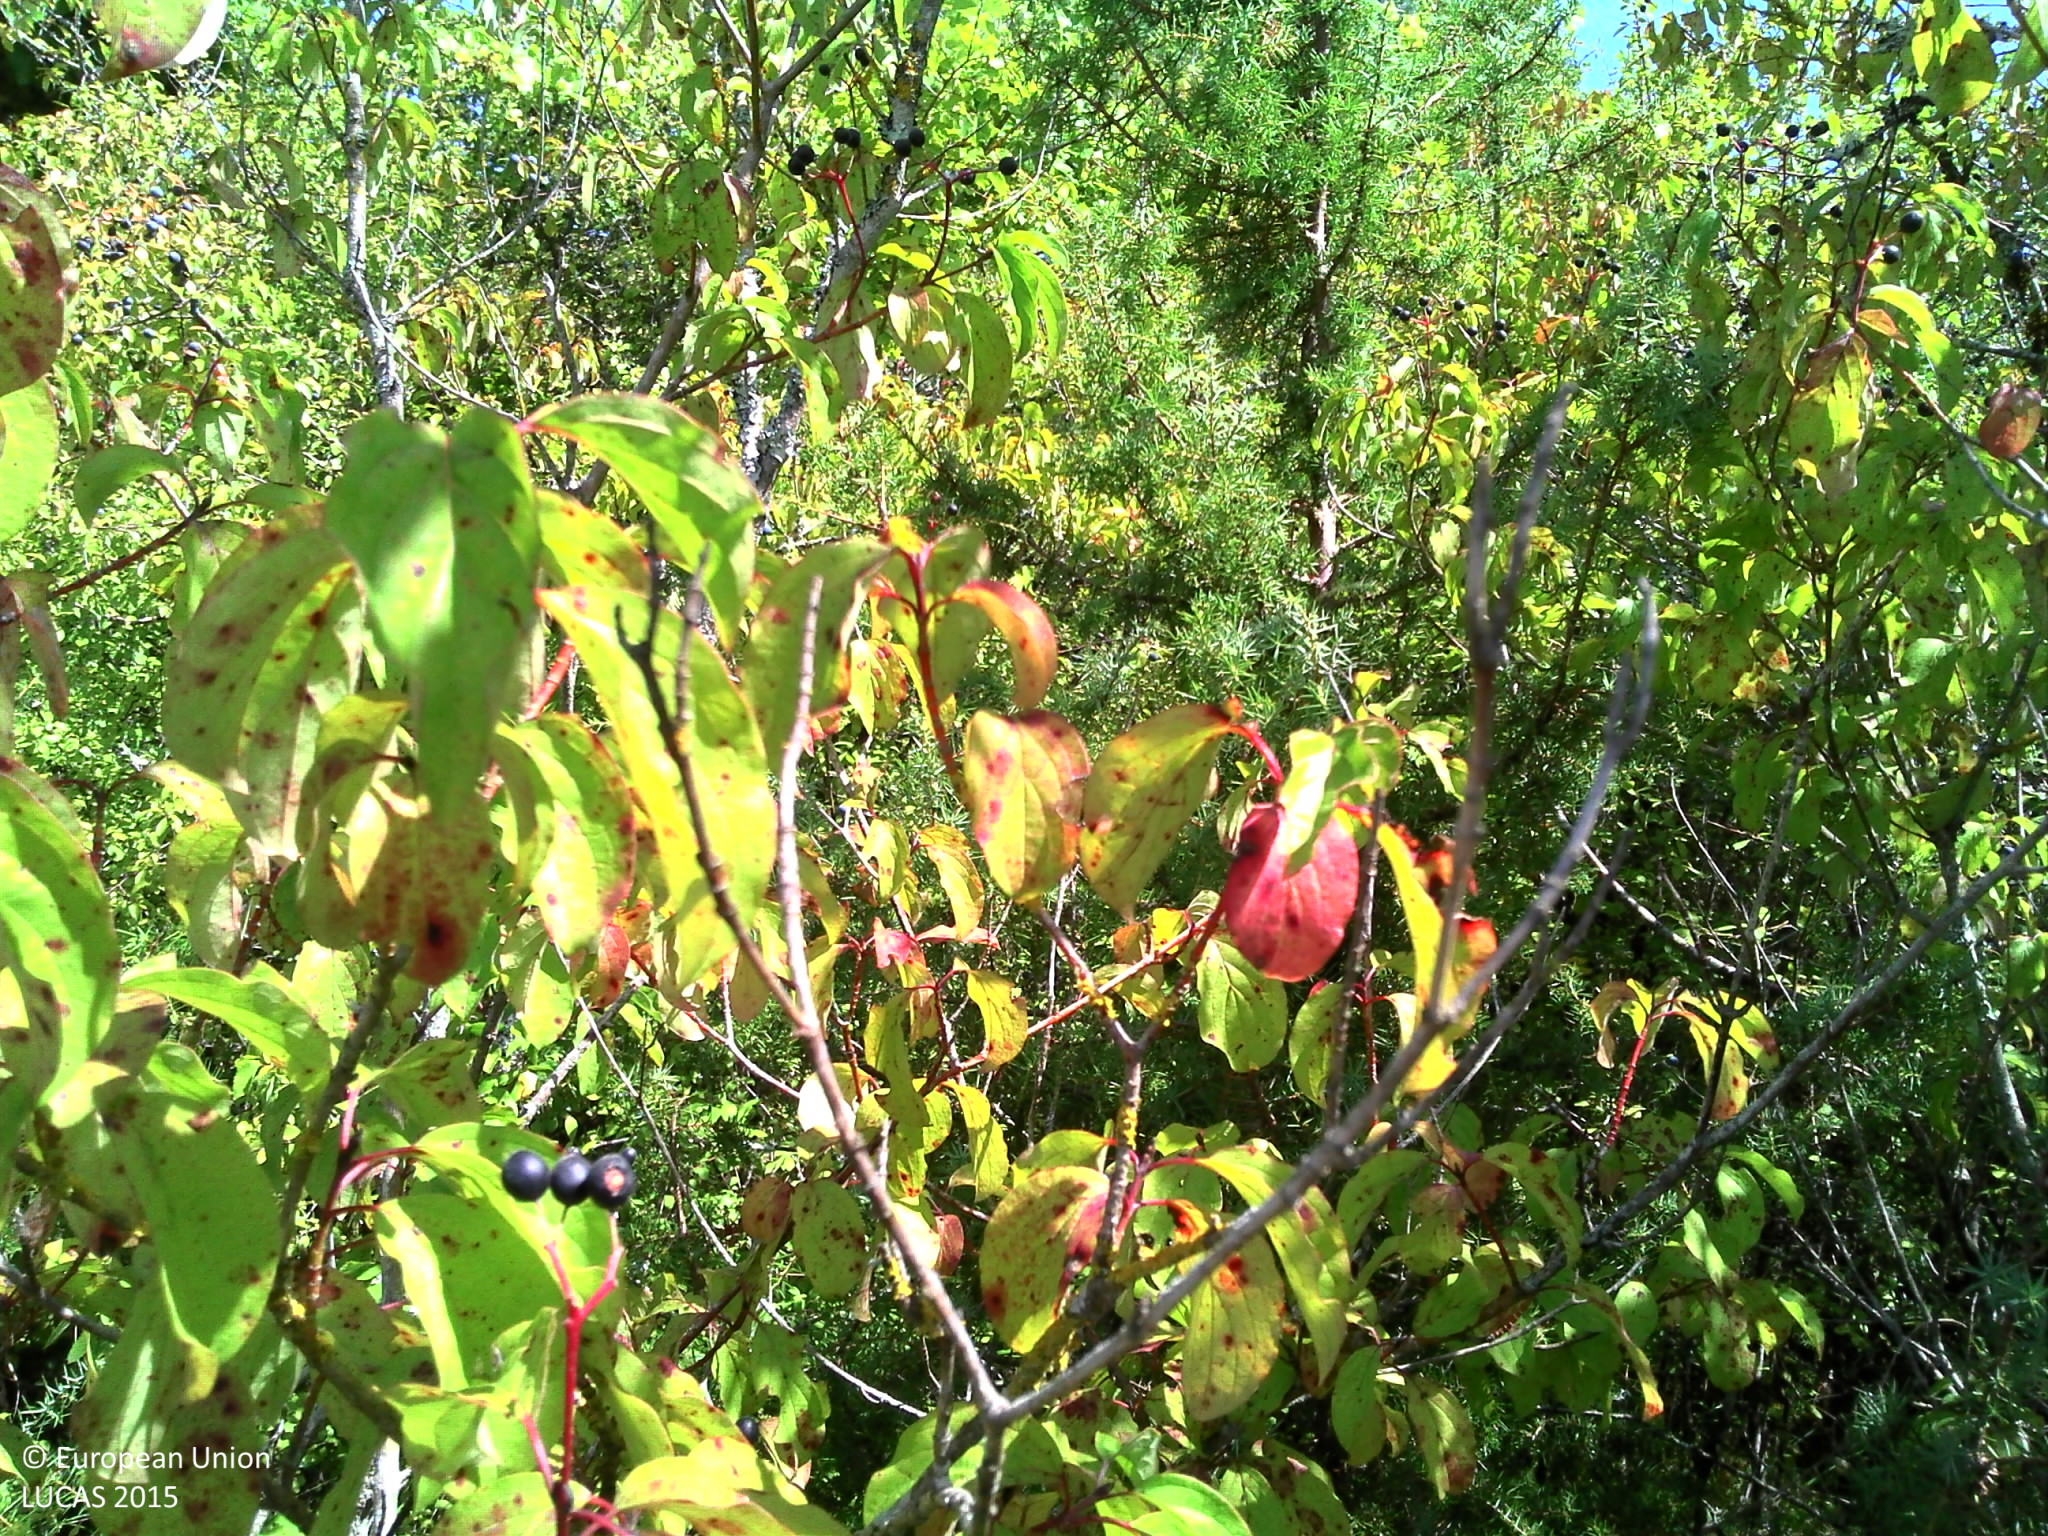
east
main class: Shrubland
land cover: Shrubland with sparse tree cover
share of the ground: > 75 %
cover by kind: shrubs 45 %, herbaceous plants 40 %, lichens and mosses 10 %, broadleaved forest trees 5 %
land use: Forestry
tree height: < 5 m
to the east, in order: Shrubland with sparse tree cover; Pine dominated mixed woodland; Spontaneously vegetated surfaces; Sunflower; Grassland without tree/shrub cover
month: August
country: FR
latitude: 45.2025
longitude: 0.5041
